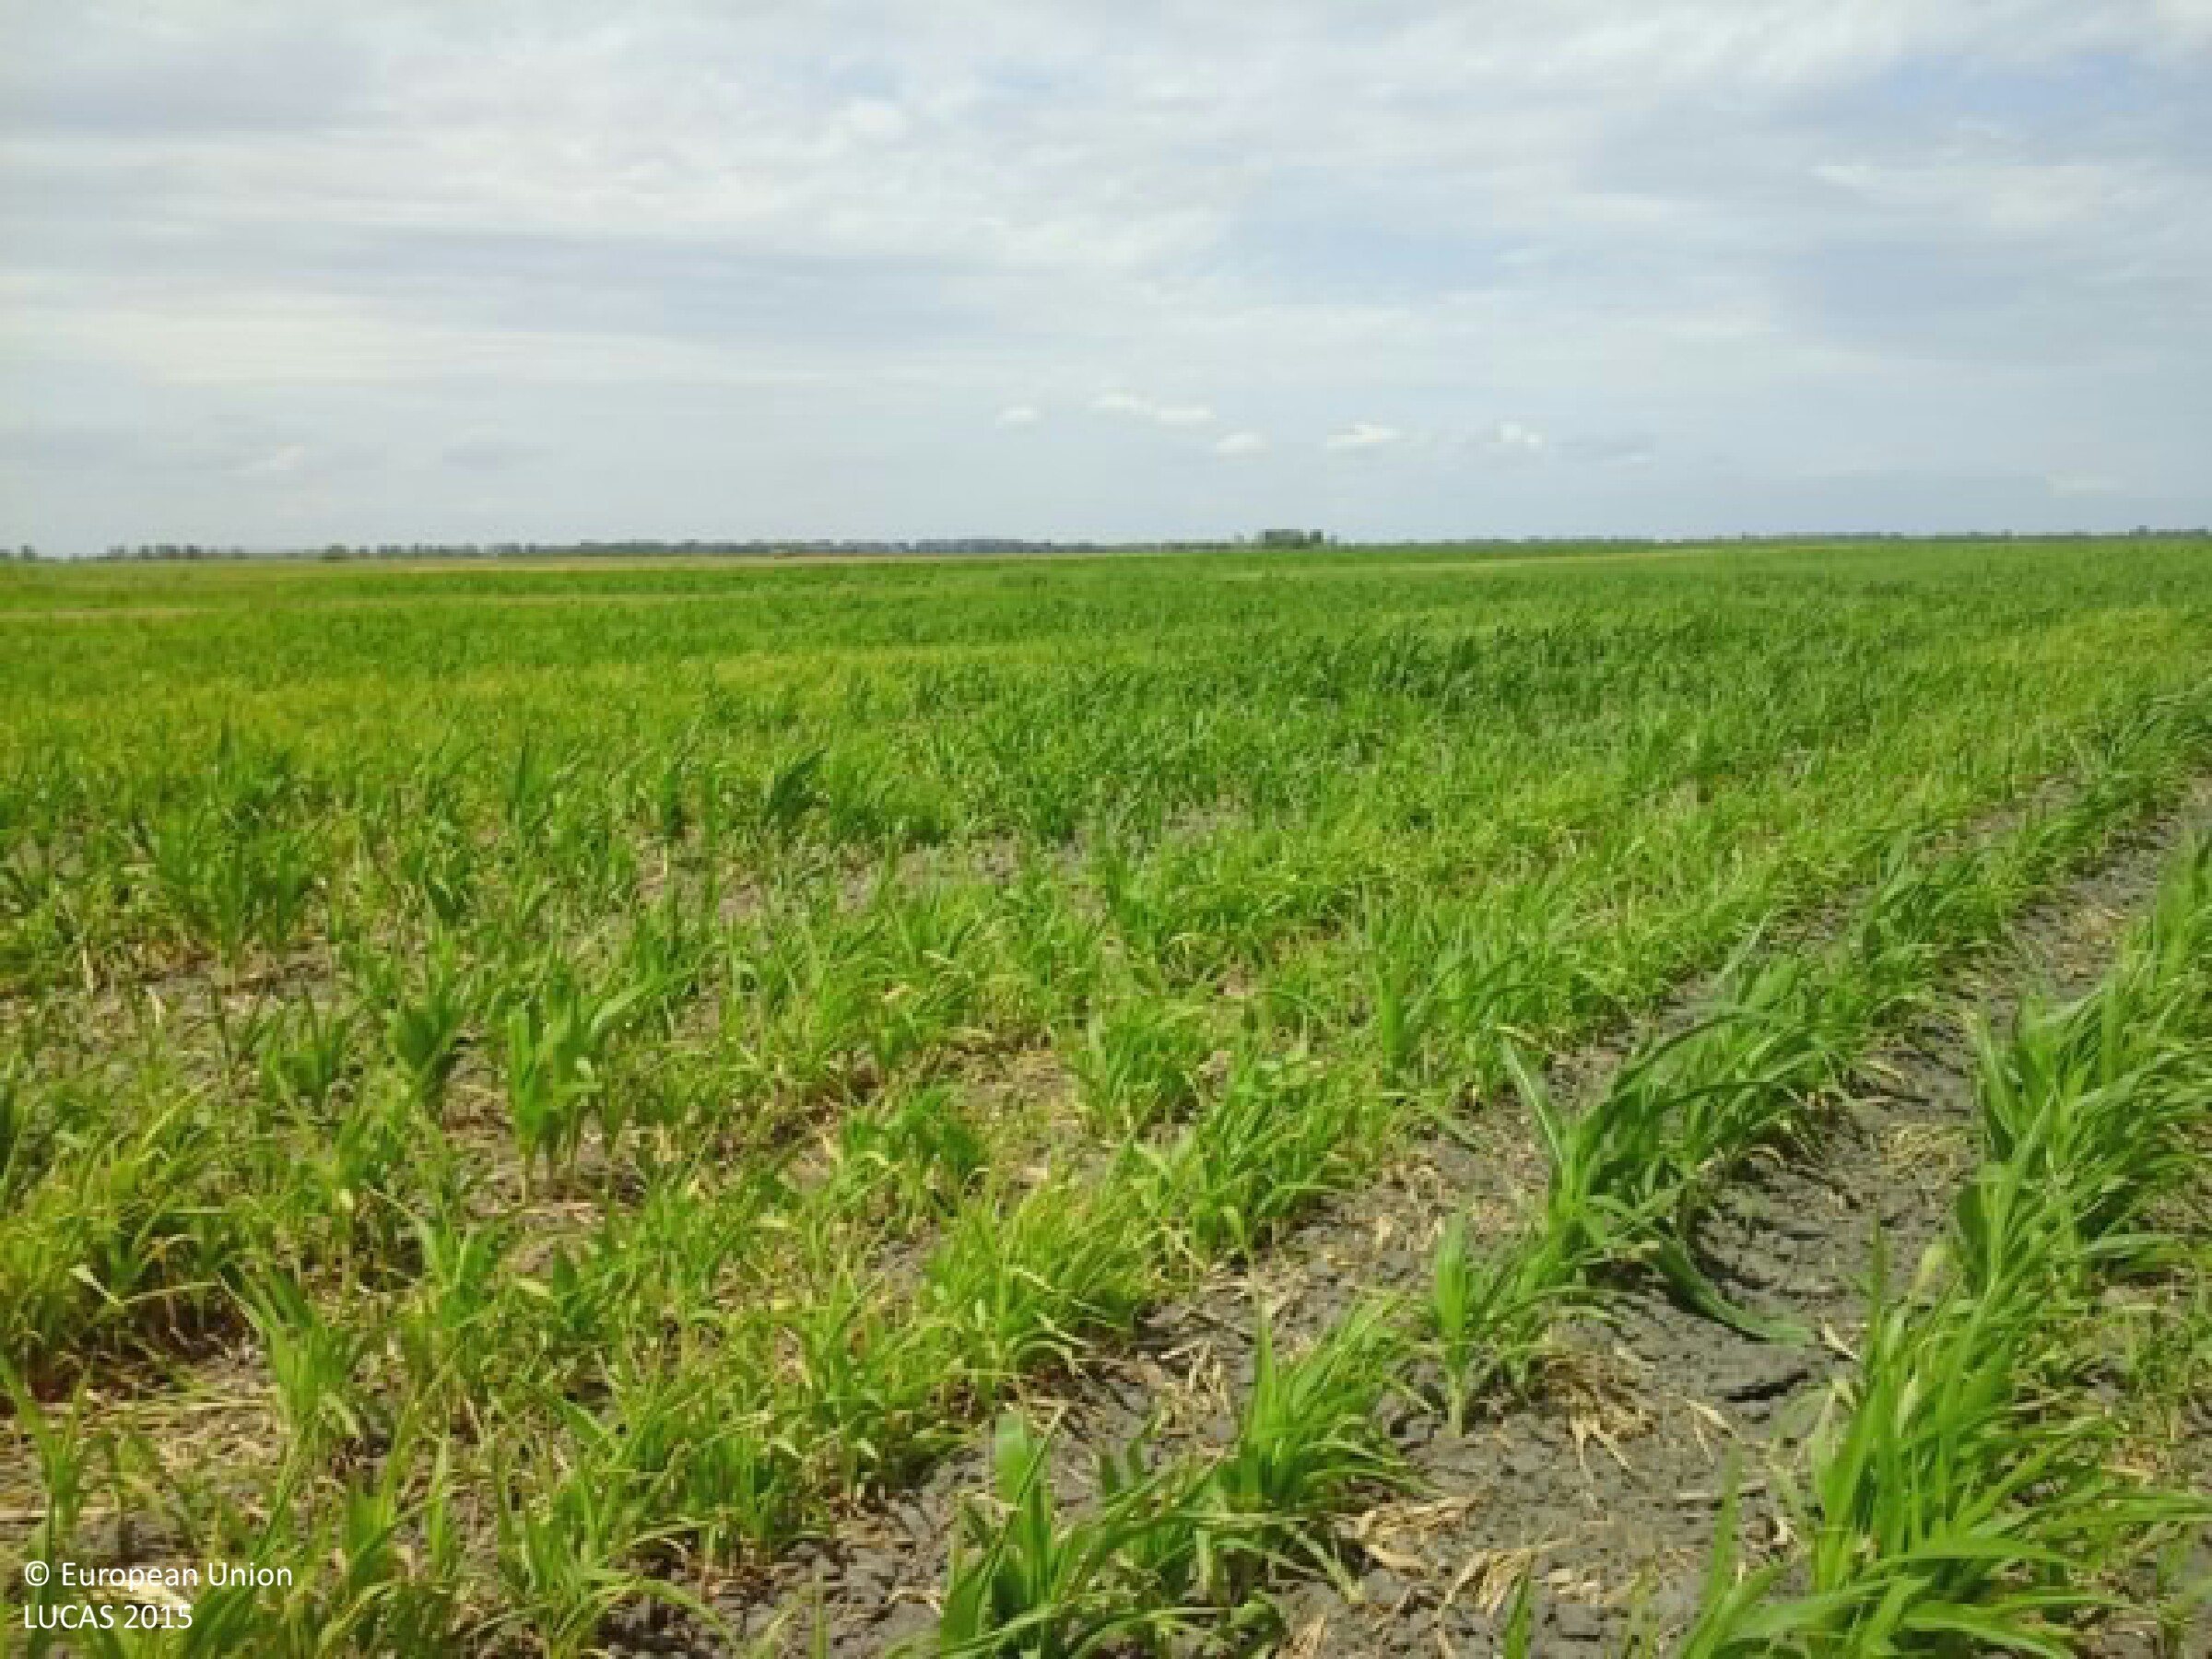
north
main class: Cropland
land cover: Maize
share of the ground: 50 - 75 %
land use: Agriculture (excluding fallow land and kitchen gardens)
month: July
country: HU
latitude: 47.1088
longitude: 19.0431
